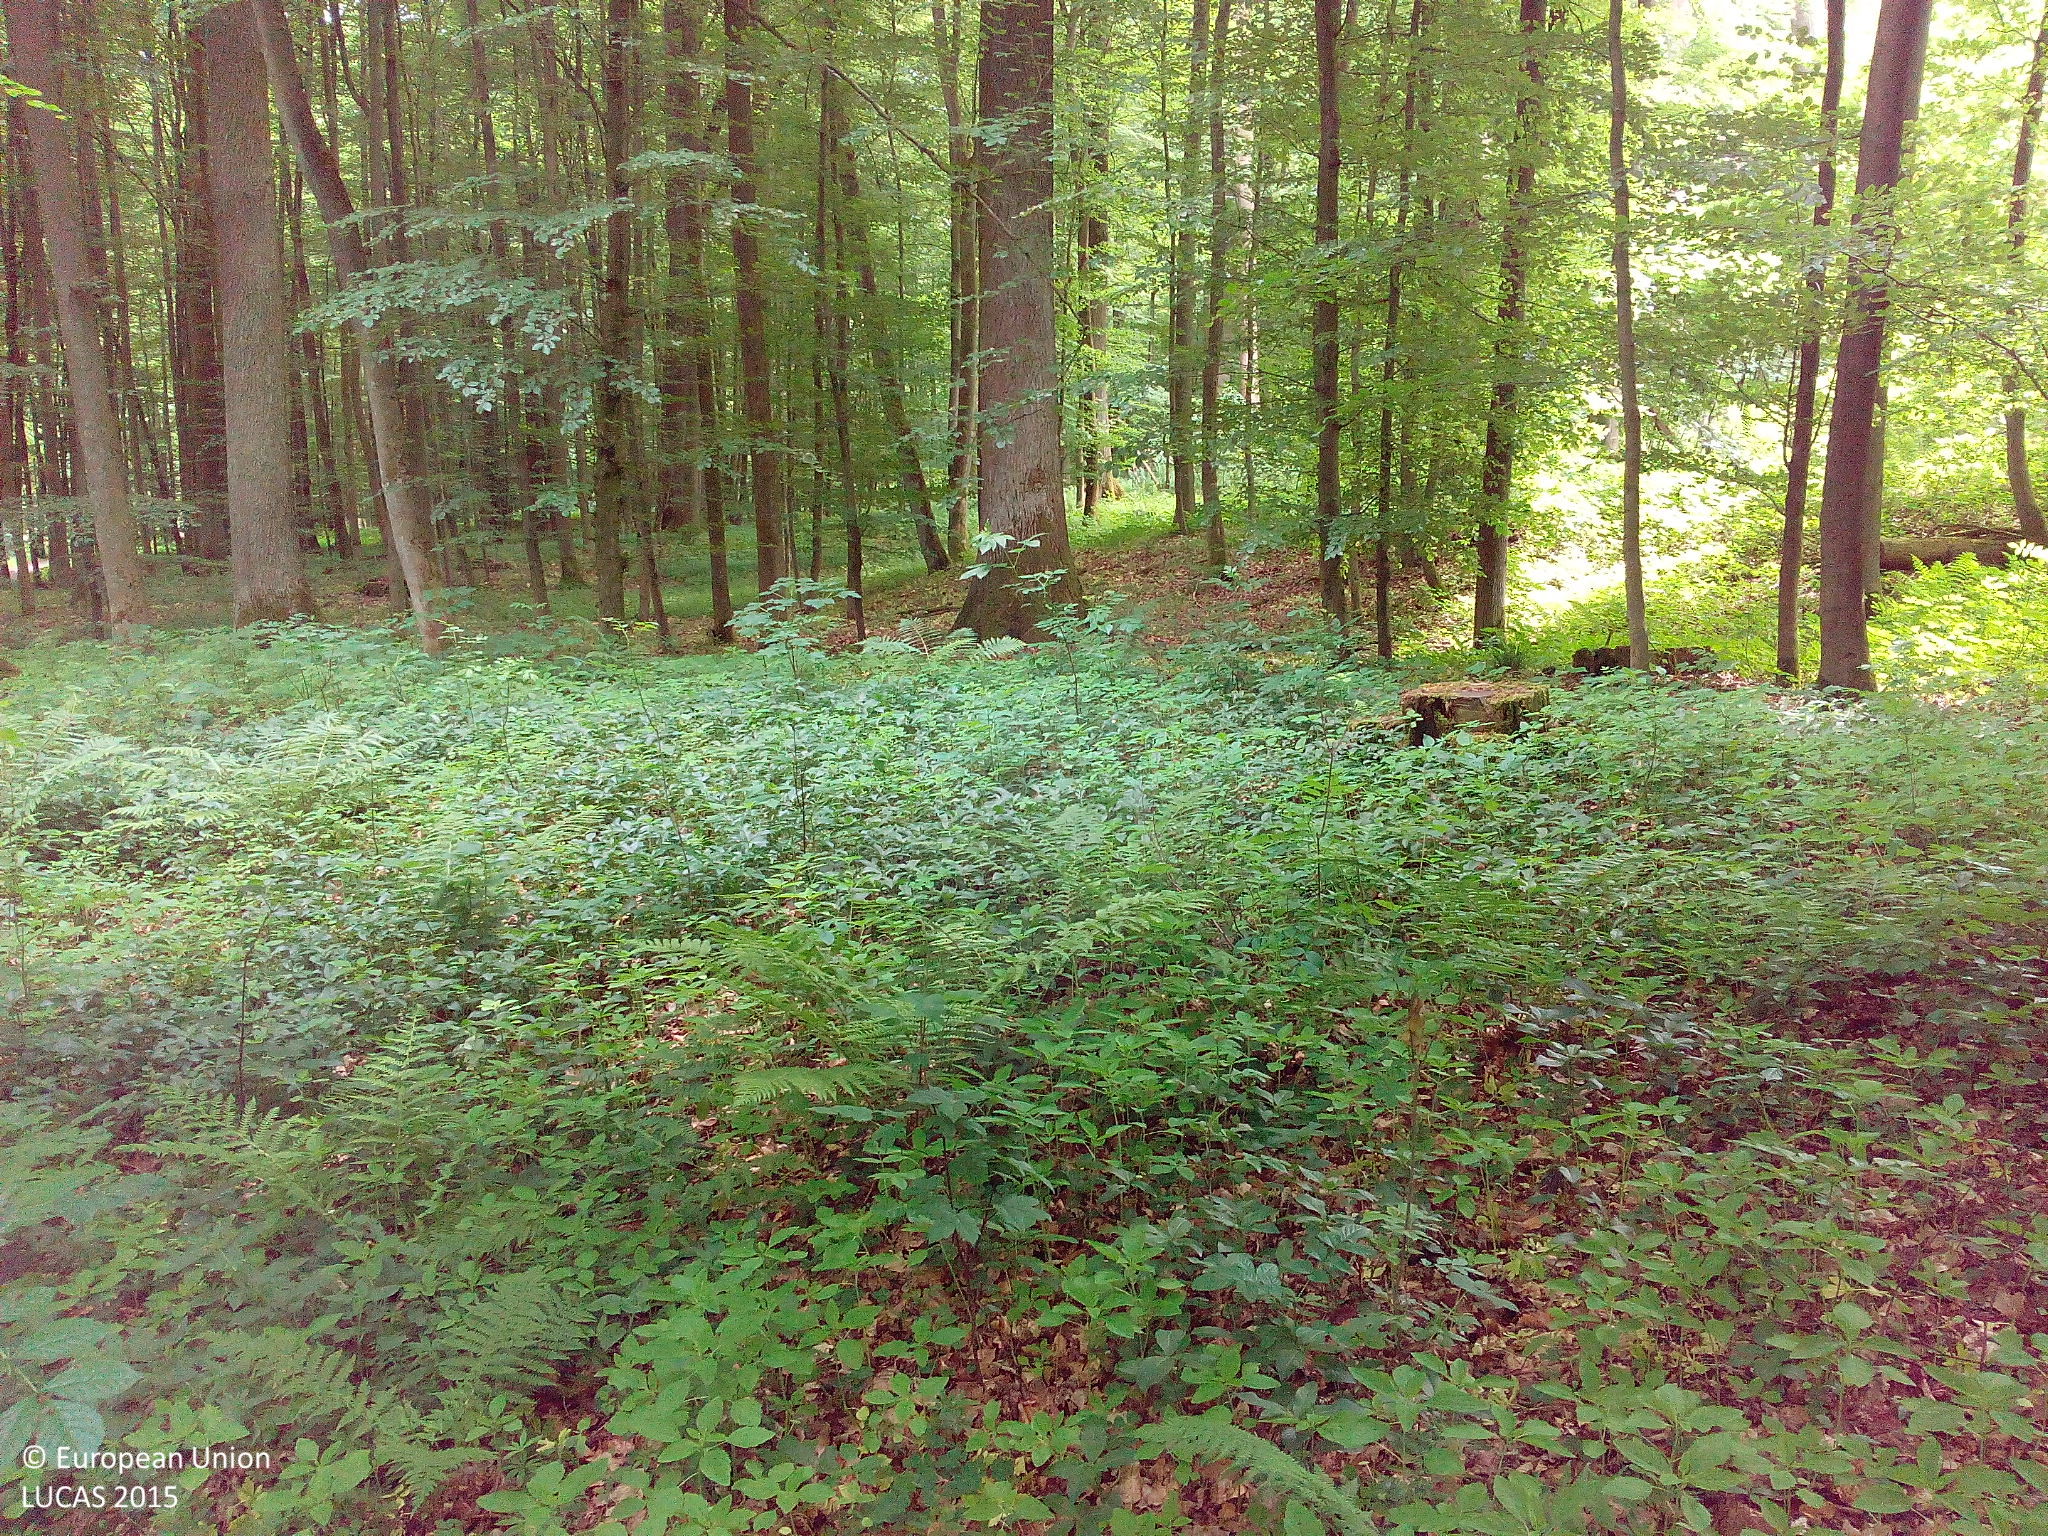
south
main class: Woodland
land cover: Broadleaved woodland
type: beech forest
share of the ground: > 75 %
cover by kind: broadleaved forest trees 100 %
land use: Forestry
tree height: > 5 m
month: June
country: DE
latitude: 51.2612
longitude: 9.3553
